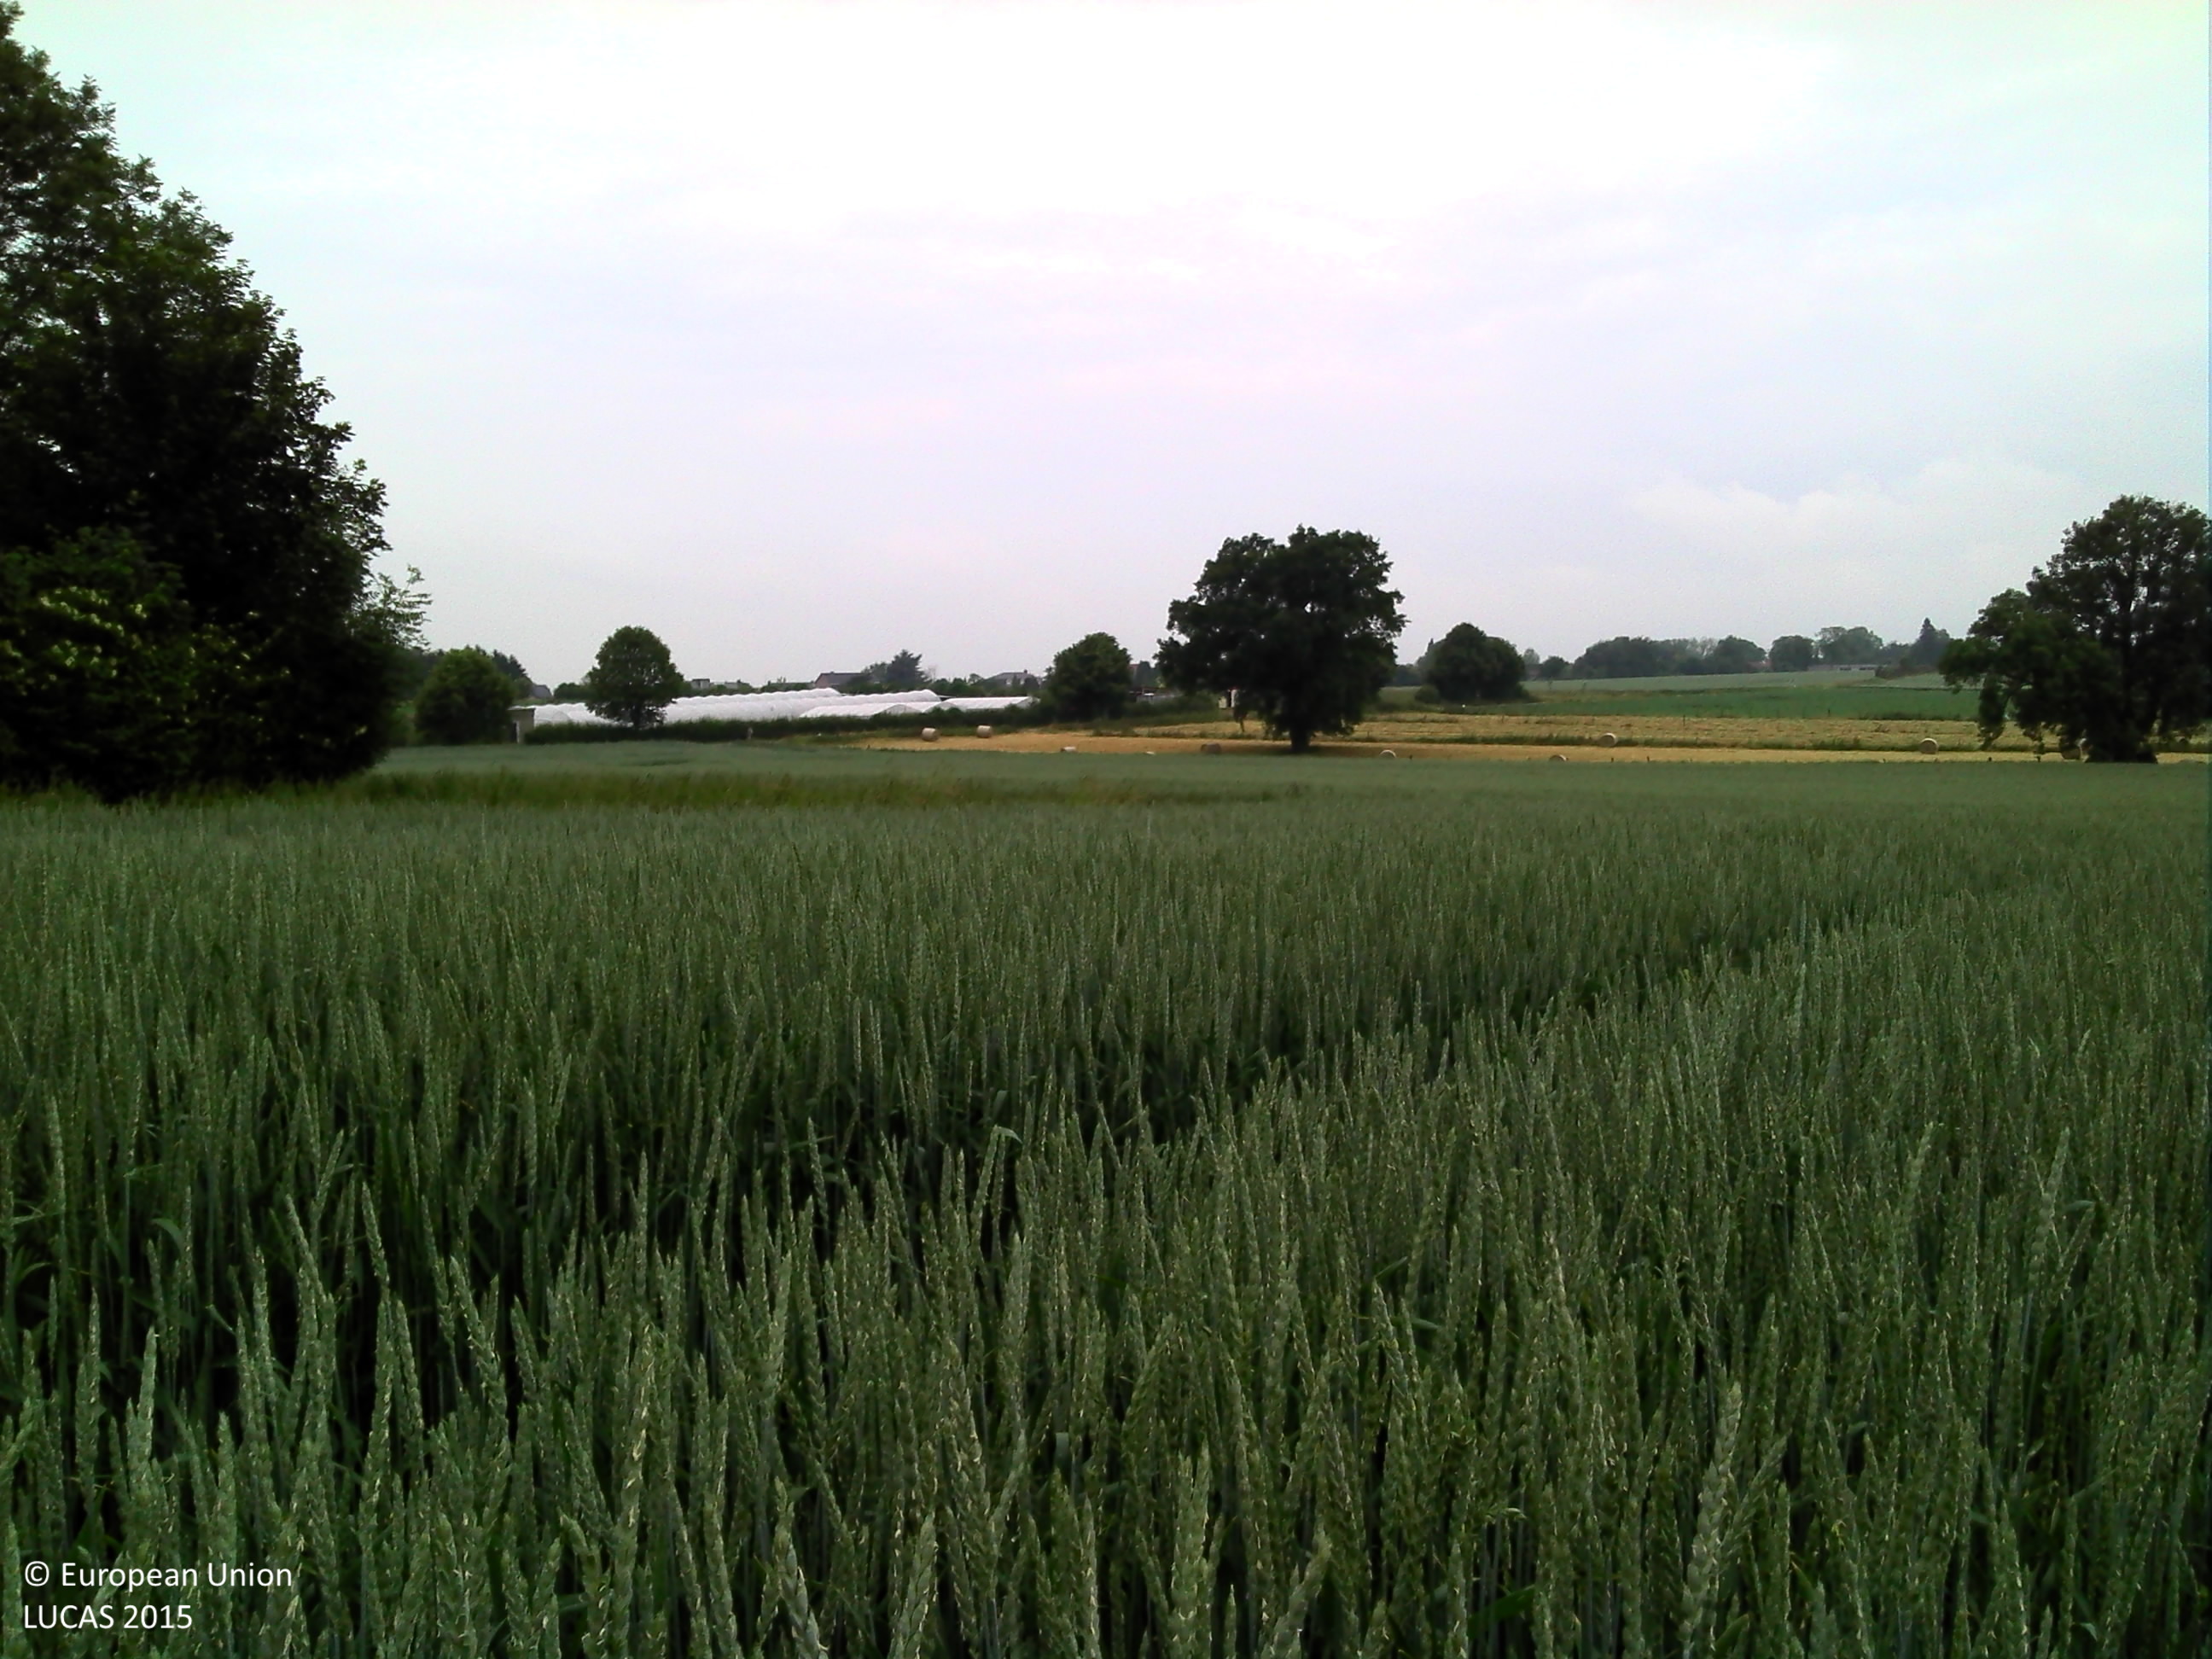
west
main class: Cropland
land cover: Other cereals
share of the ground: > 75 %
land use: Agriculture (excluding fallow land and kitchen gardens)
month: June
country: BE
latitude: 50.7070
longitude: 5.4809
